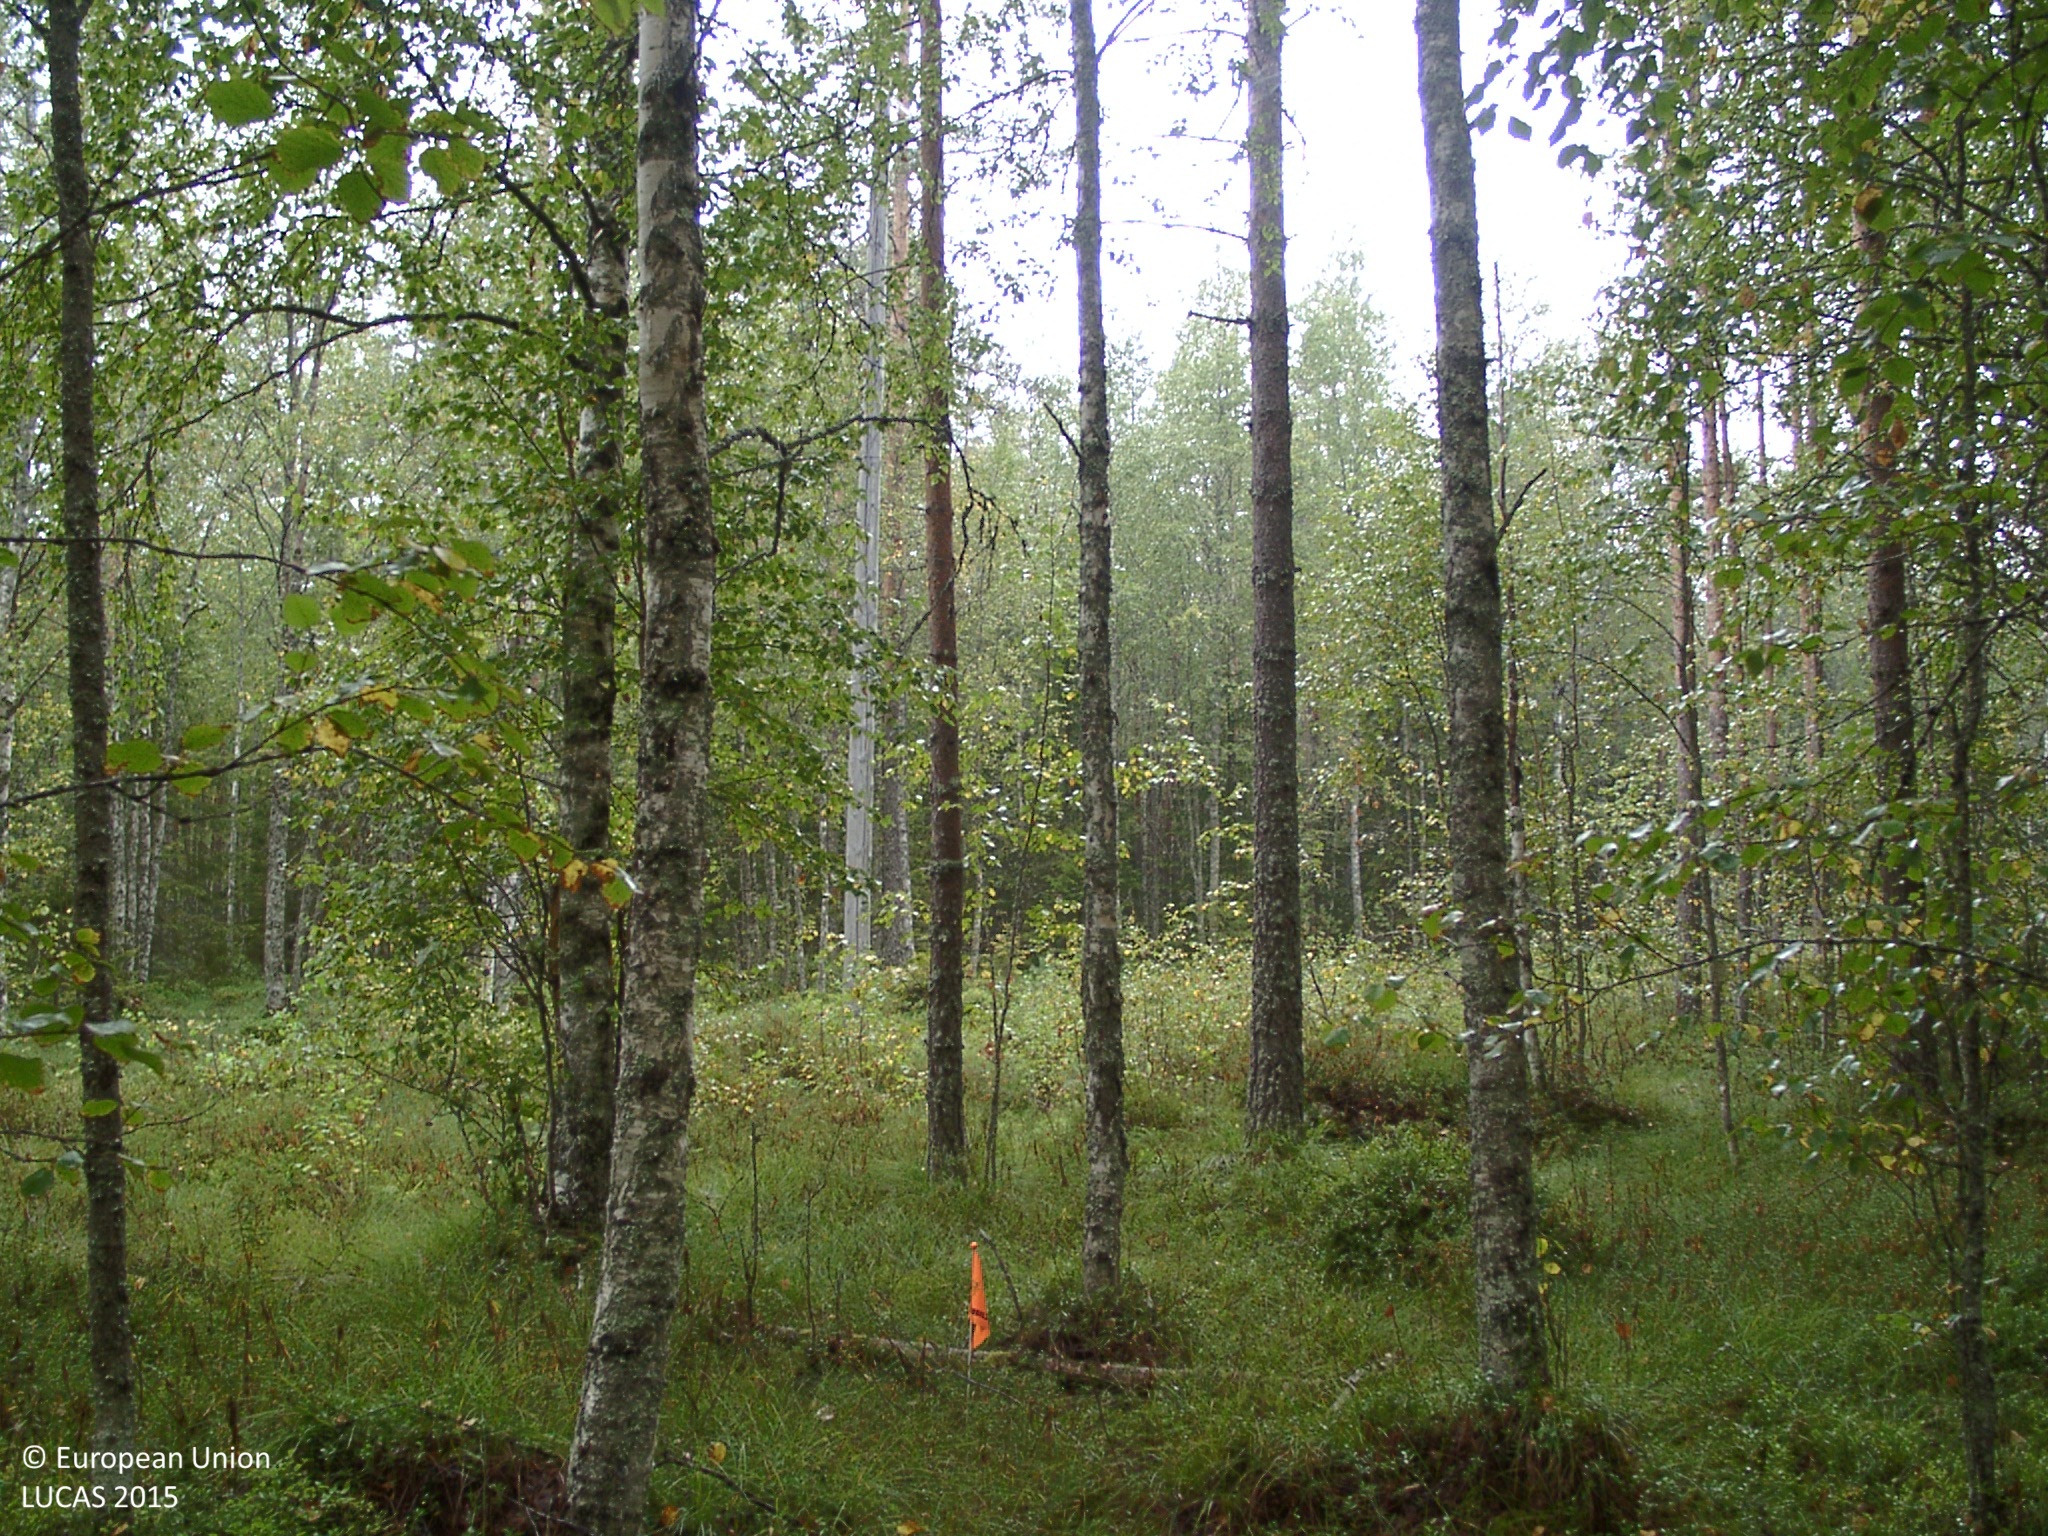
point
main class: Woodland
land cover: Pine dominated mixed woodland
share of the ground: > 75 %
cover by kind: broadleaved forest trees 40 %, coniferous forest trees 35 %, shrubs 15 %, herbaceous plants 5 %, lichens and mosses 5 %
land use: Forestry
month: August
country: FI
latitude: 62.4440
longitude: 25.0012
